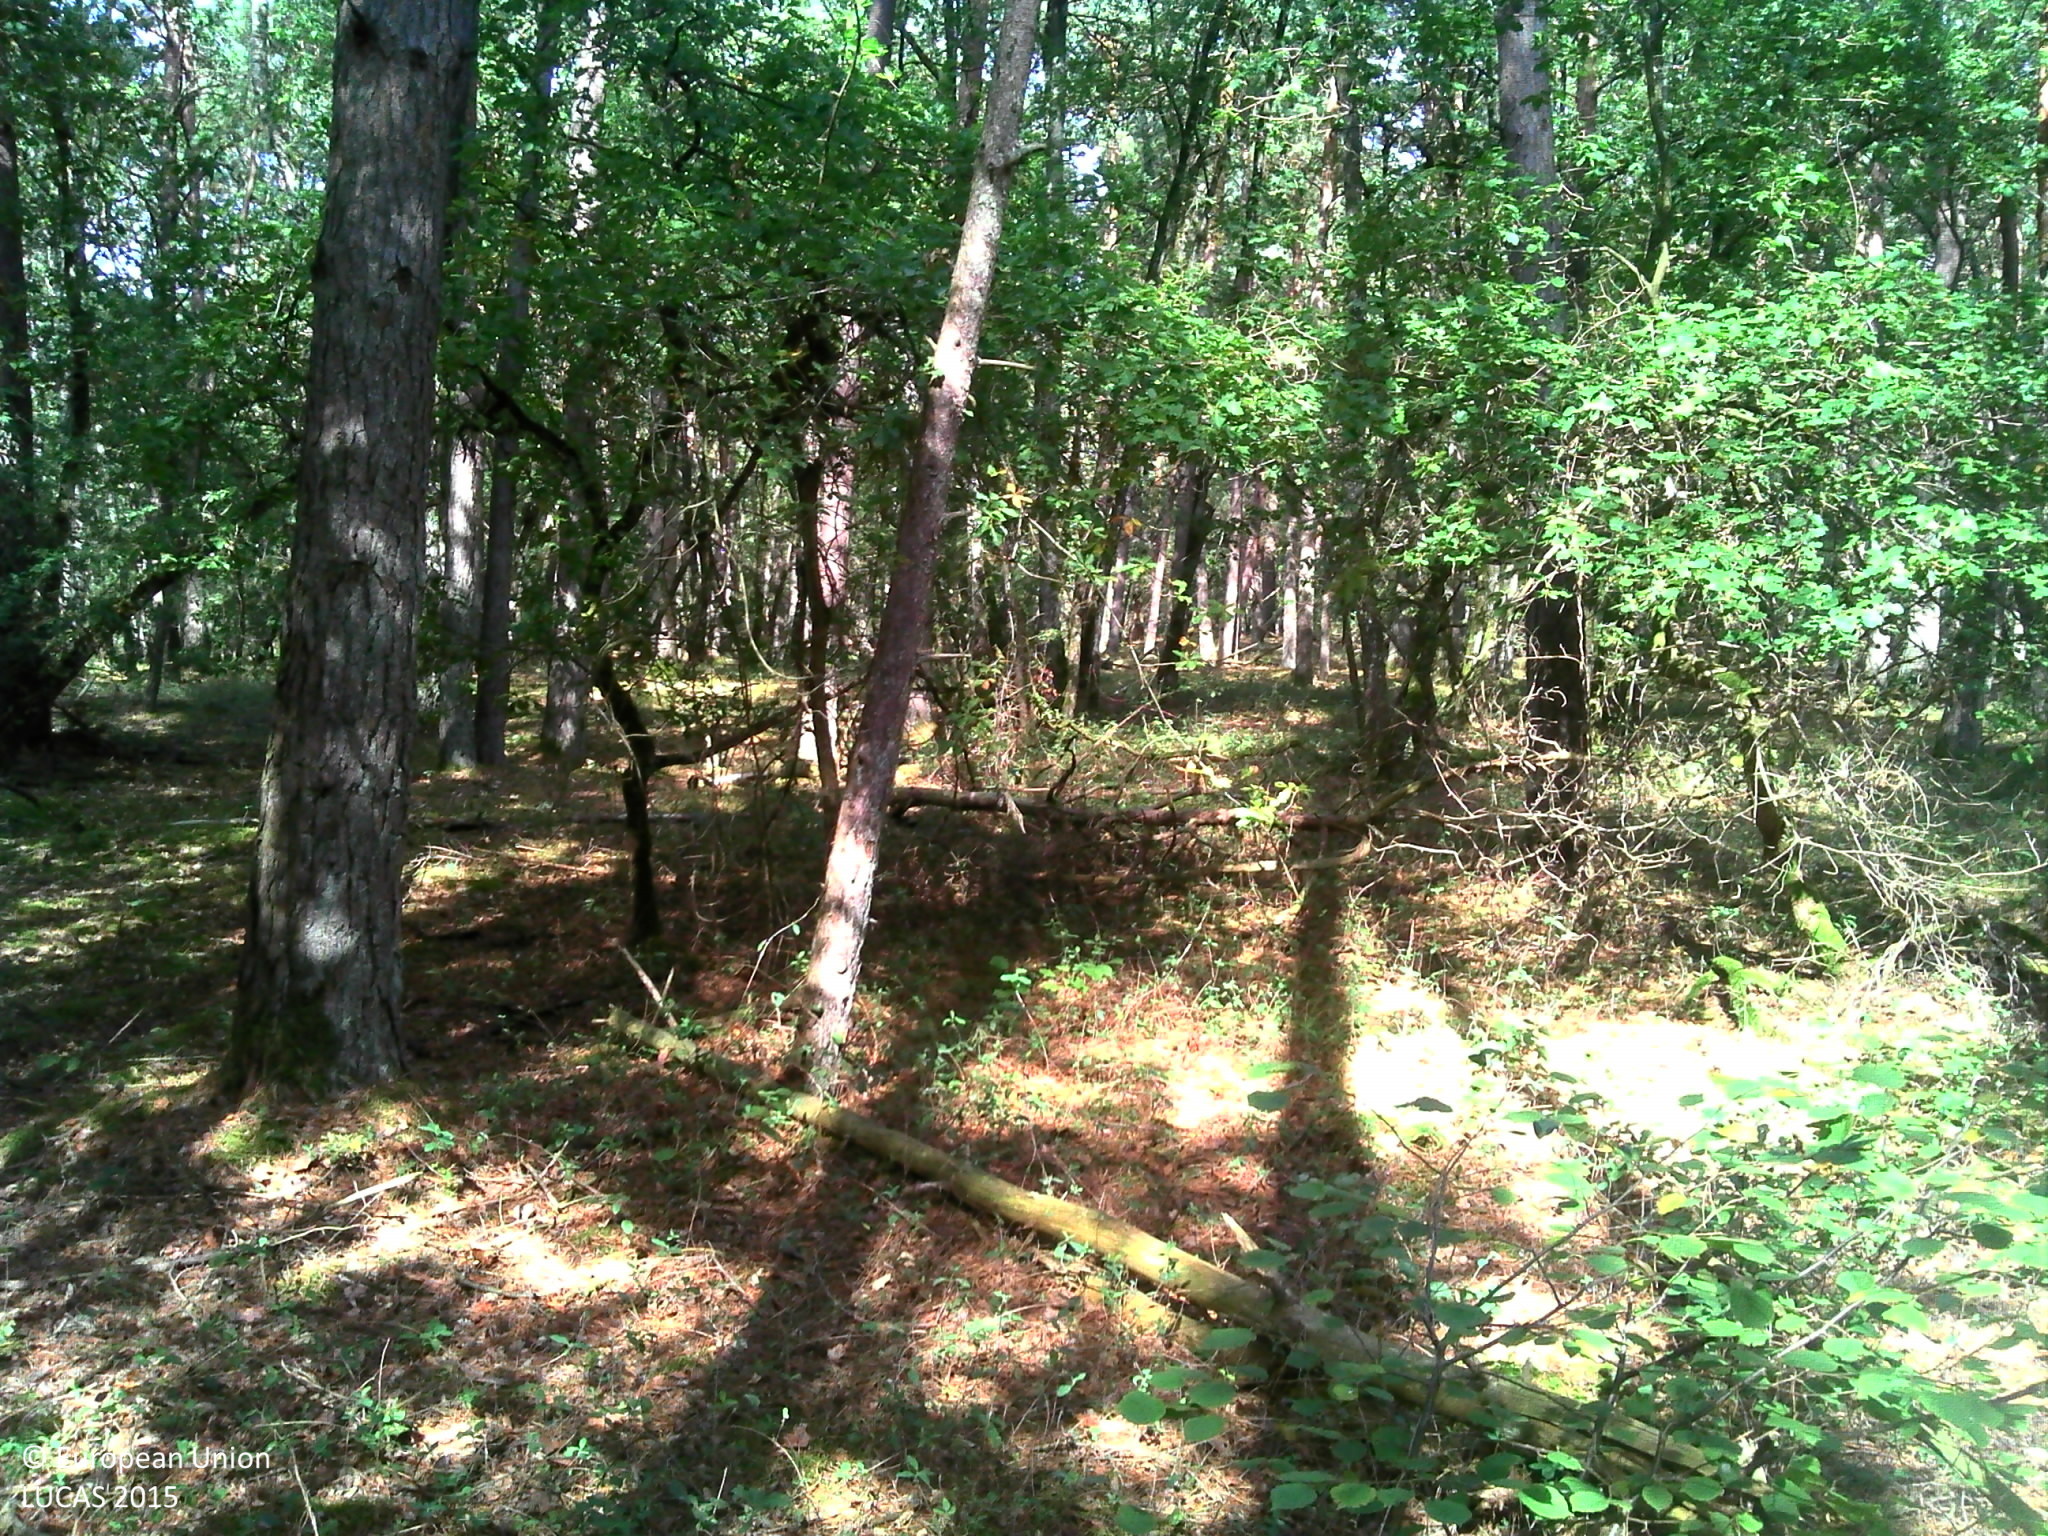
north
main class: Woodland
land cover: Pine dominated mixed woodland
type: acidophilous oak and oak-birch forest
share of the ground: > 75 %
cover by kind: coniferous forest trees 50 %, broadleaved forest trees 40 %, herbaceous plants 5 %, lichens and mosses 5 %
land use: Forestry
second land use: Amenities, museums, leisure
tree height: > 5 m
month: September
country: FR
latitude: 48.2383
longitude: 2.7608
